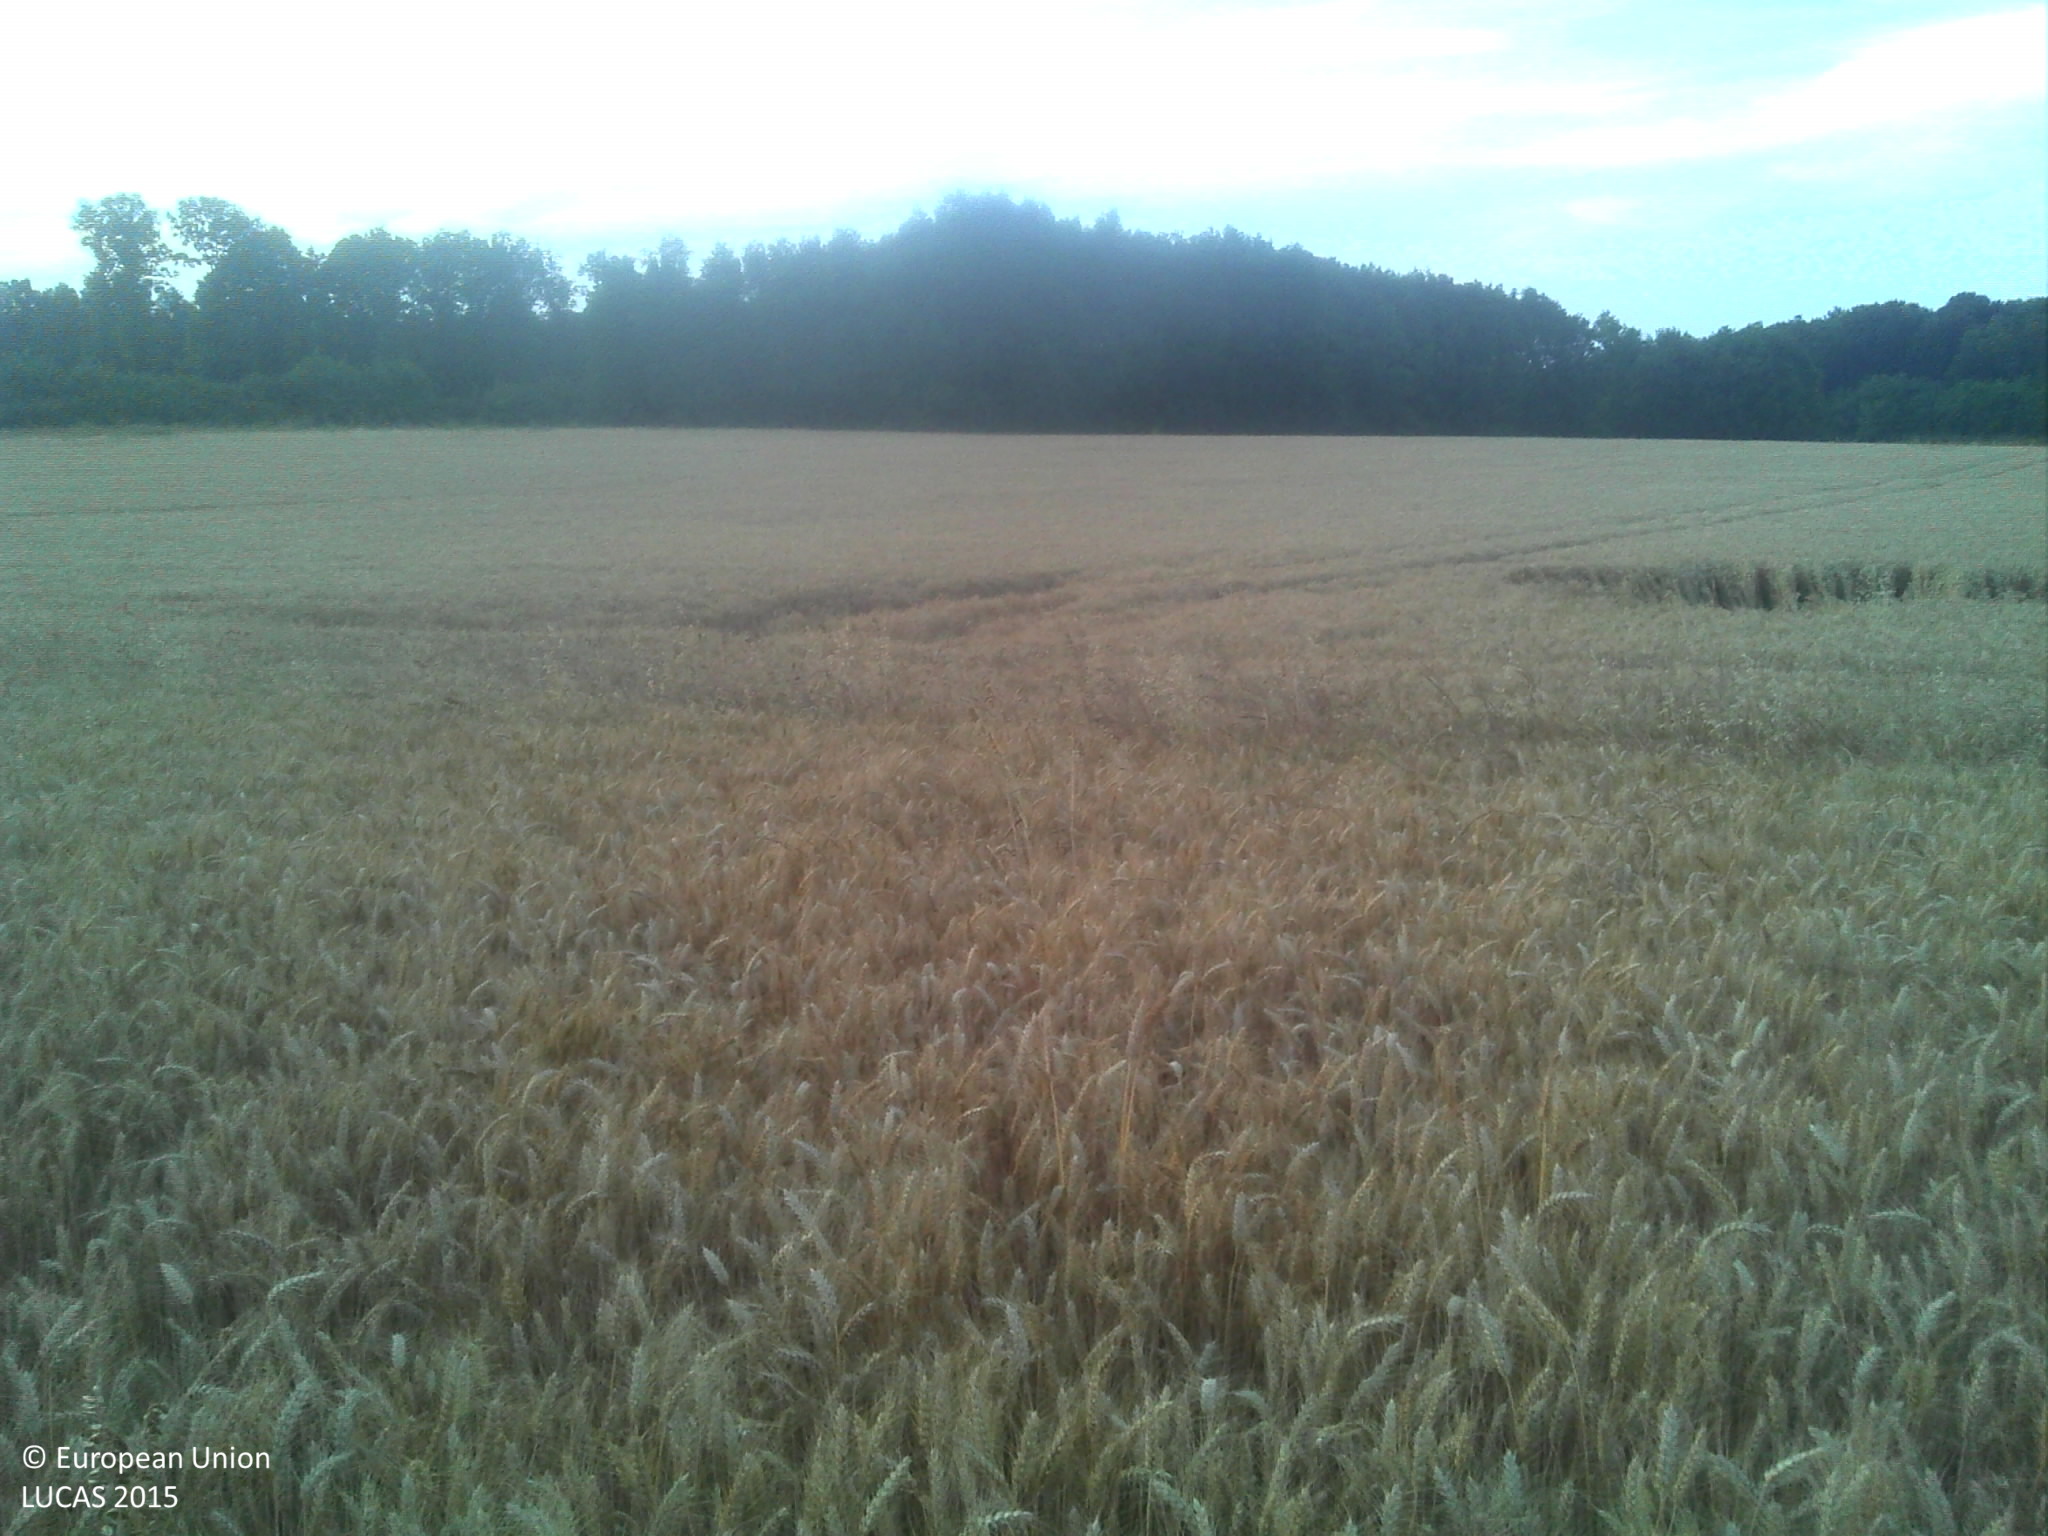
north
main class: Cropland
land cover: Common wheat
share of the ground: > 75 %
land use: Agriculture (excluding fallow land and kitchen gardens)
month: July
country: FR
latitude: 47.7244
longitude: 0.9557
